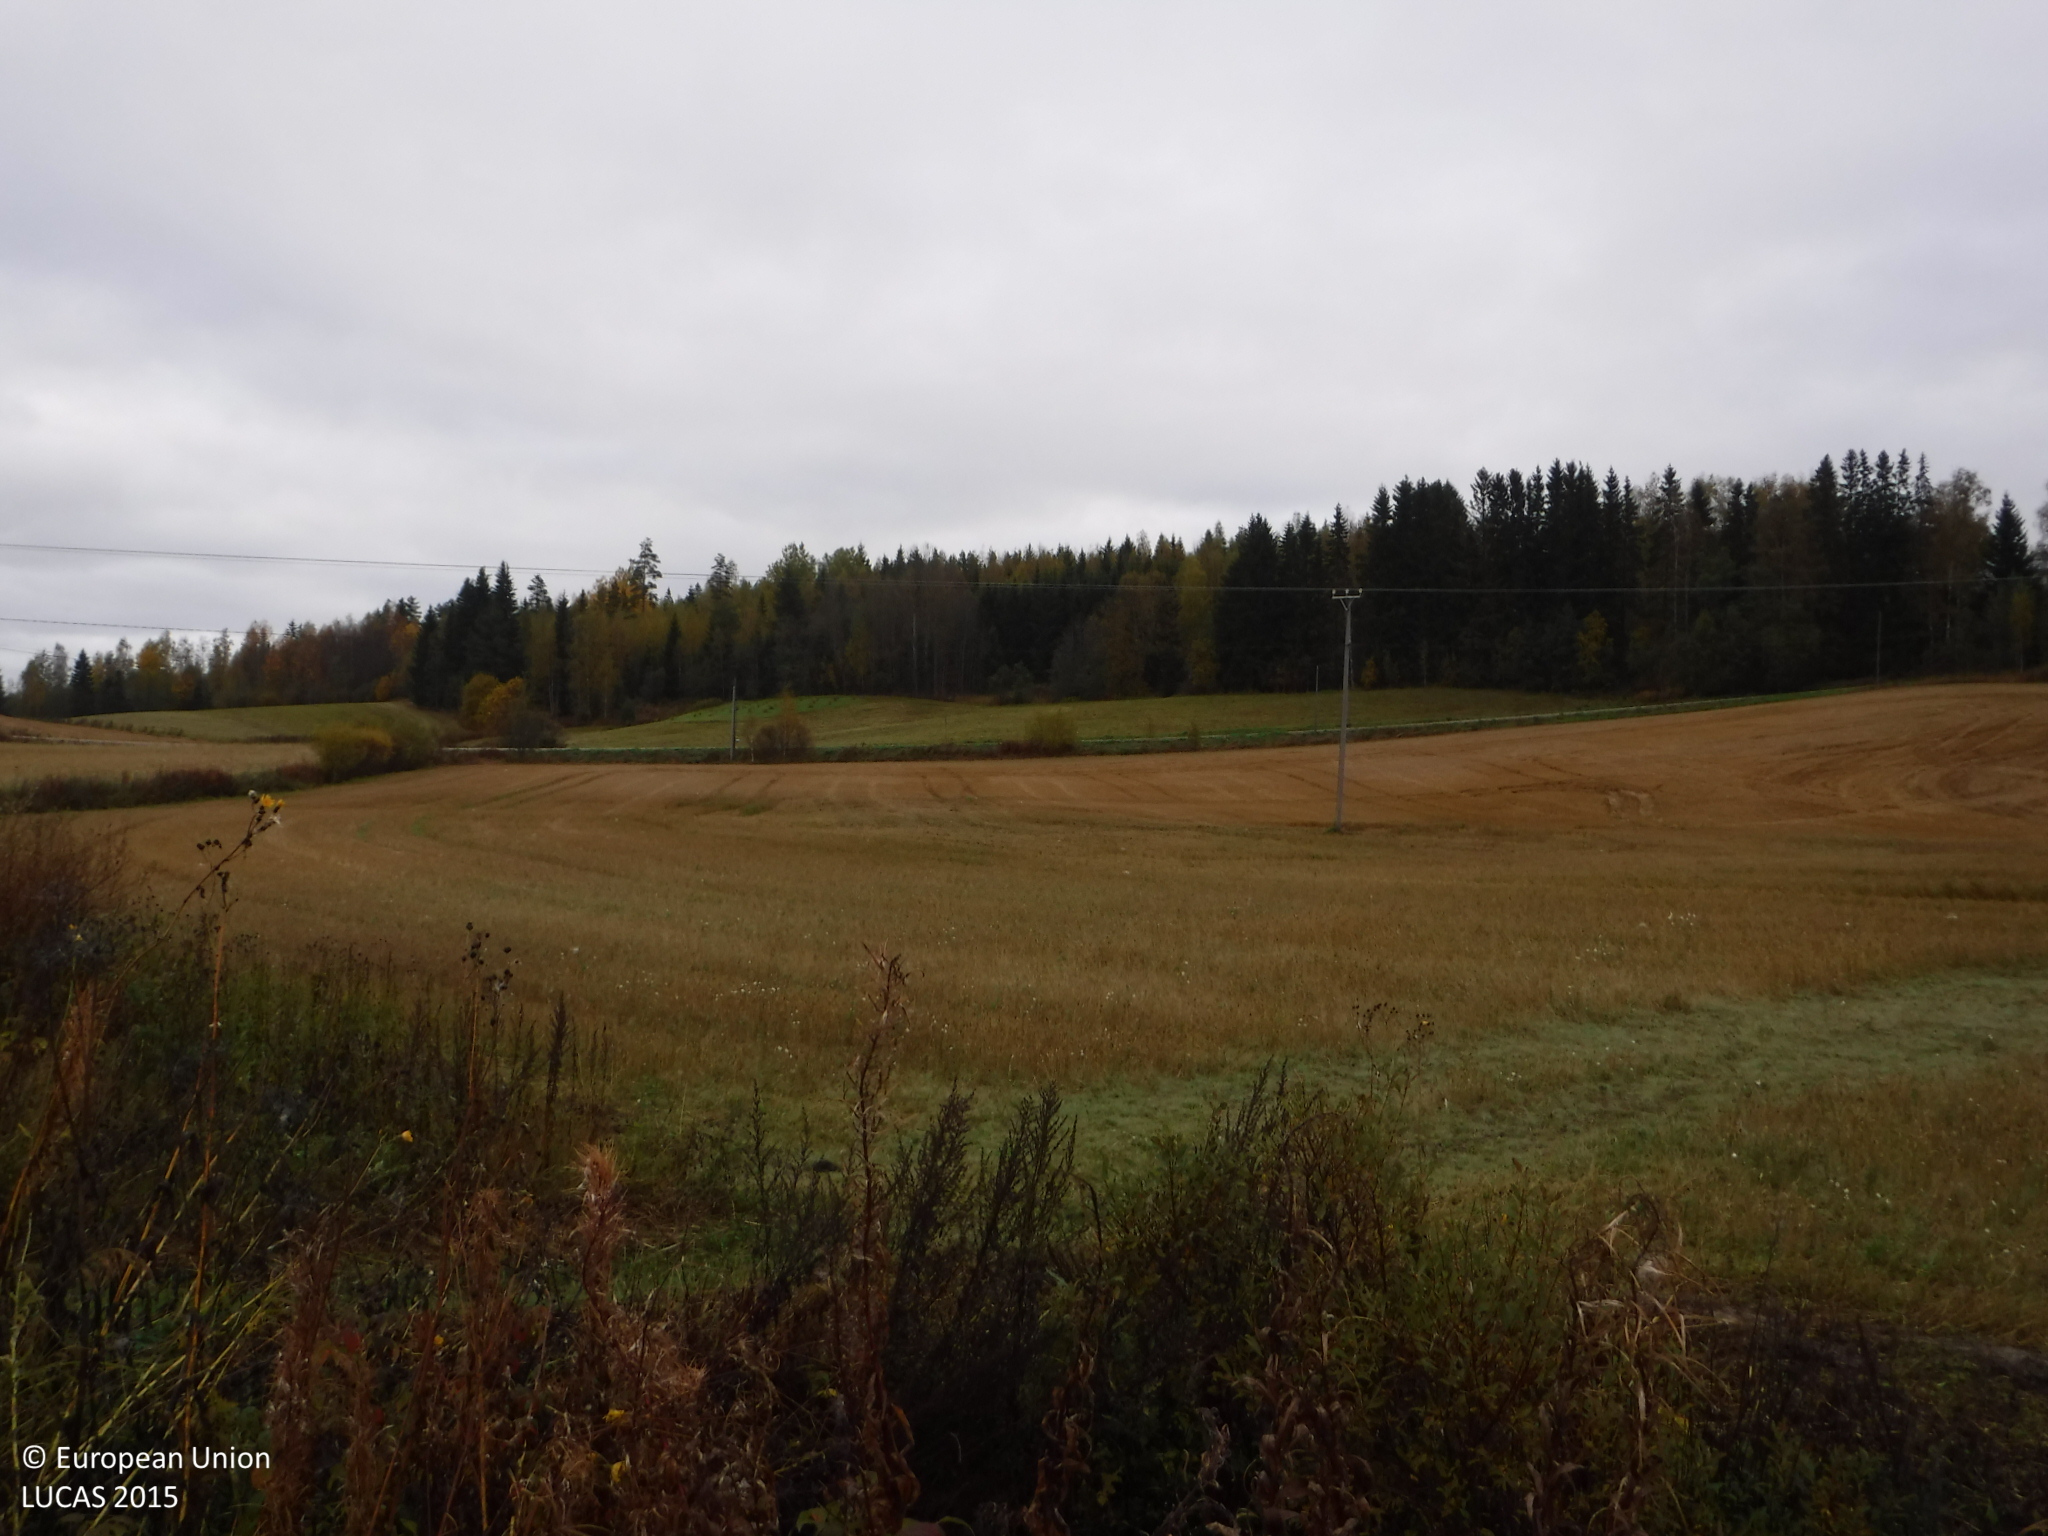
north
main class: Cropland
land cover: Common wheat
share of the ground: > 75 %
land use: Agriculture (excluding fallow land and kitchen gardens)
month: September
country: FI
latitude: 61.7078
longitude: 24.4507
